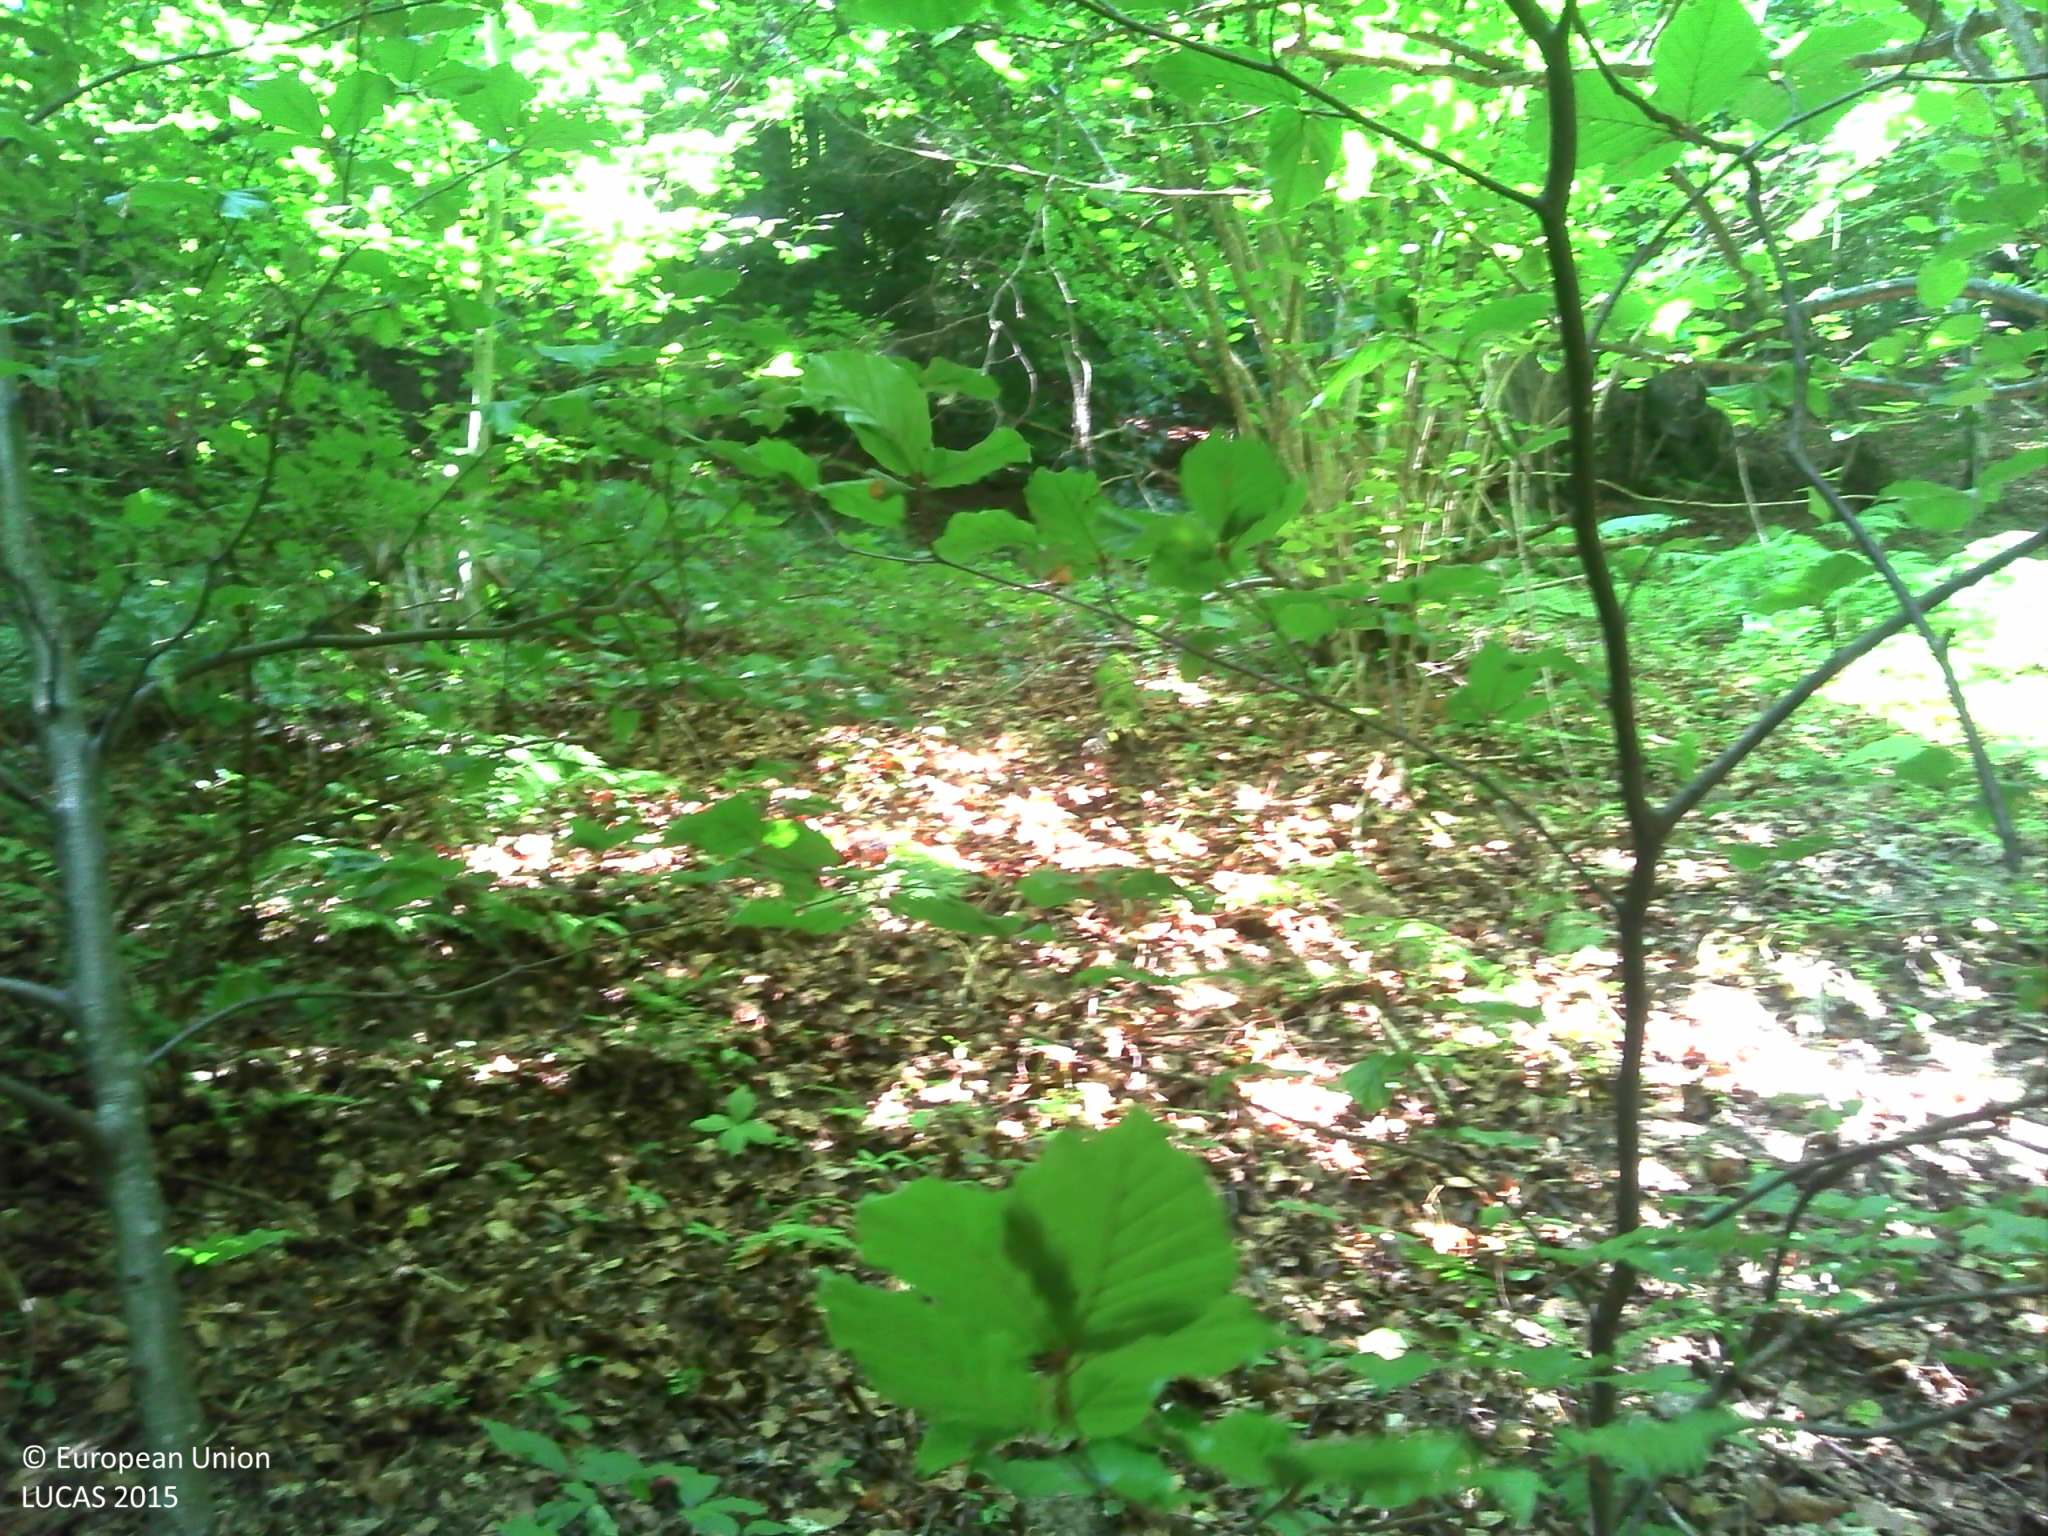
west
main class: Woodland
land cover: Spruce dominated mixed woodland
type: mountainous beech forest
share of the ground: > 75 %
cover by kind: broadleaved forest trees 40 %, coniferous forest trees 35 %, herbaceous plants 20 %, lichens and mosses 5 %
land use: Forestry
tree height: > 5 m
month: July
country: FR
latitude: 45.8871
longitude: 6.2026
